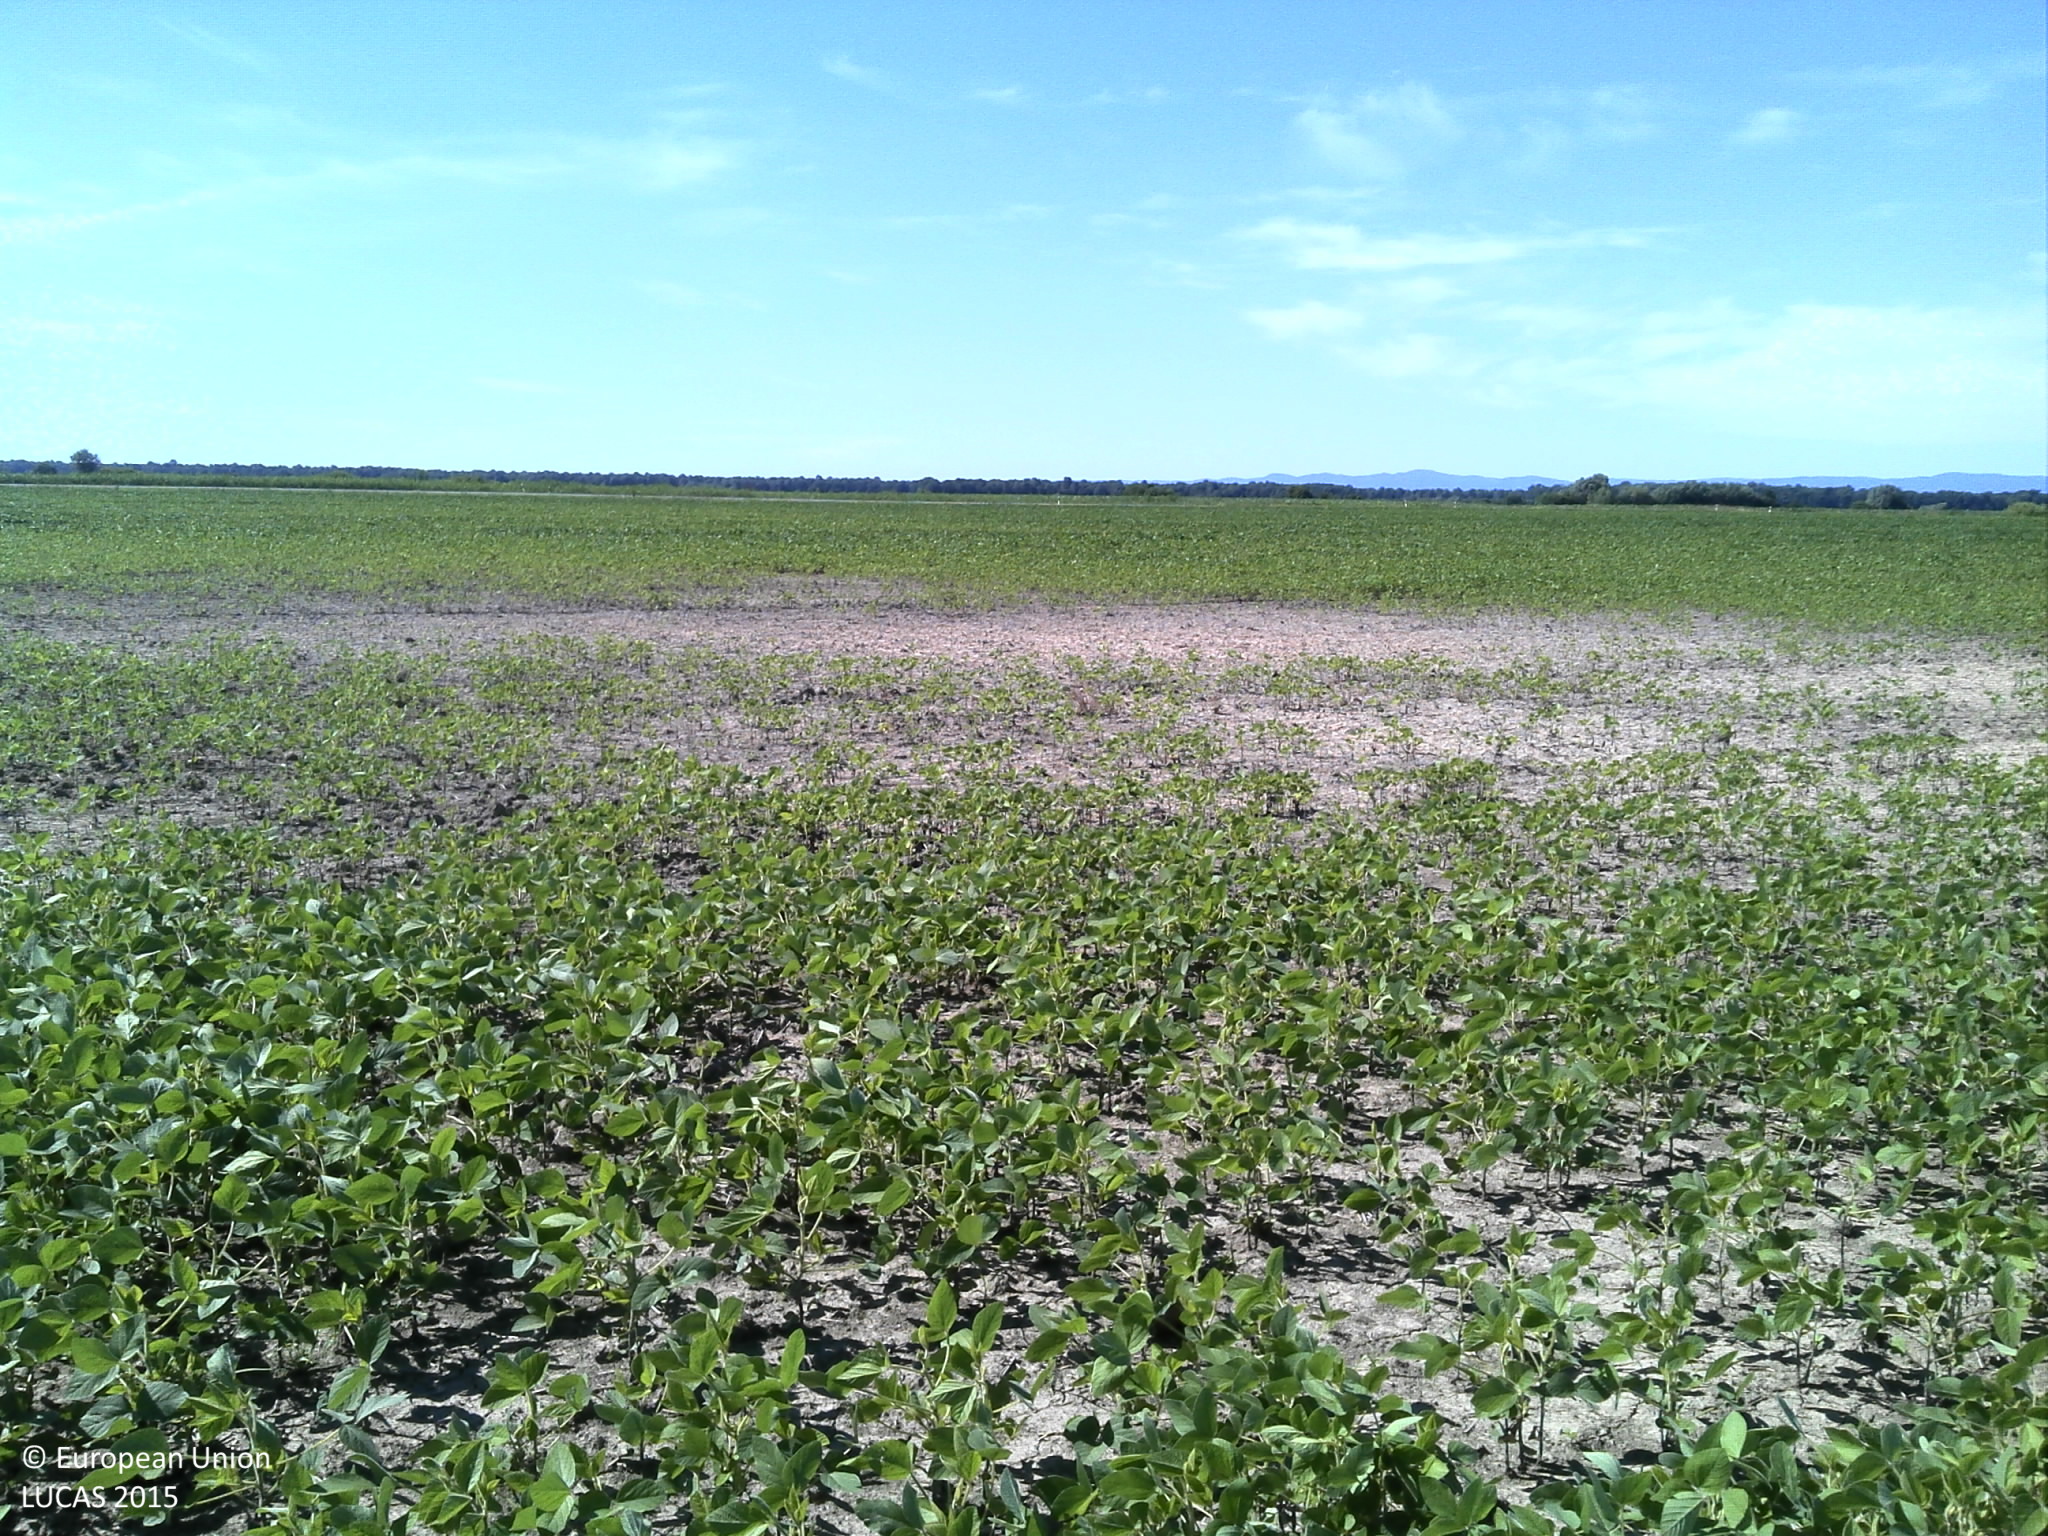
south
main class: Cropland
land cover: Soya
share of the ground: 50 - 75 %
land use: Agriculture (excluding fallow land and kitchen gardens)
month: June
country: HR
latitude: 45.7663
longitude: 17.9381
